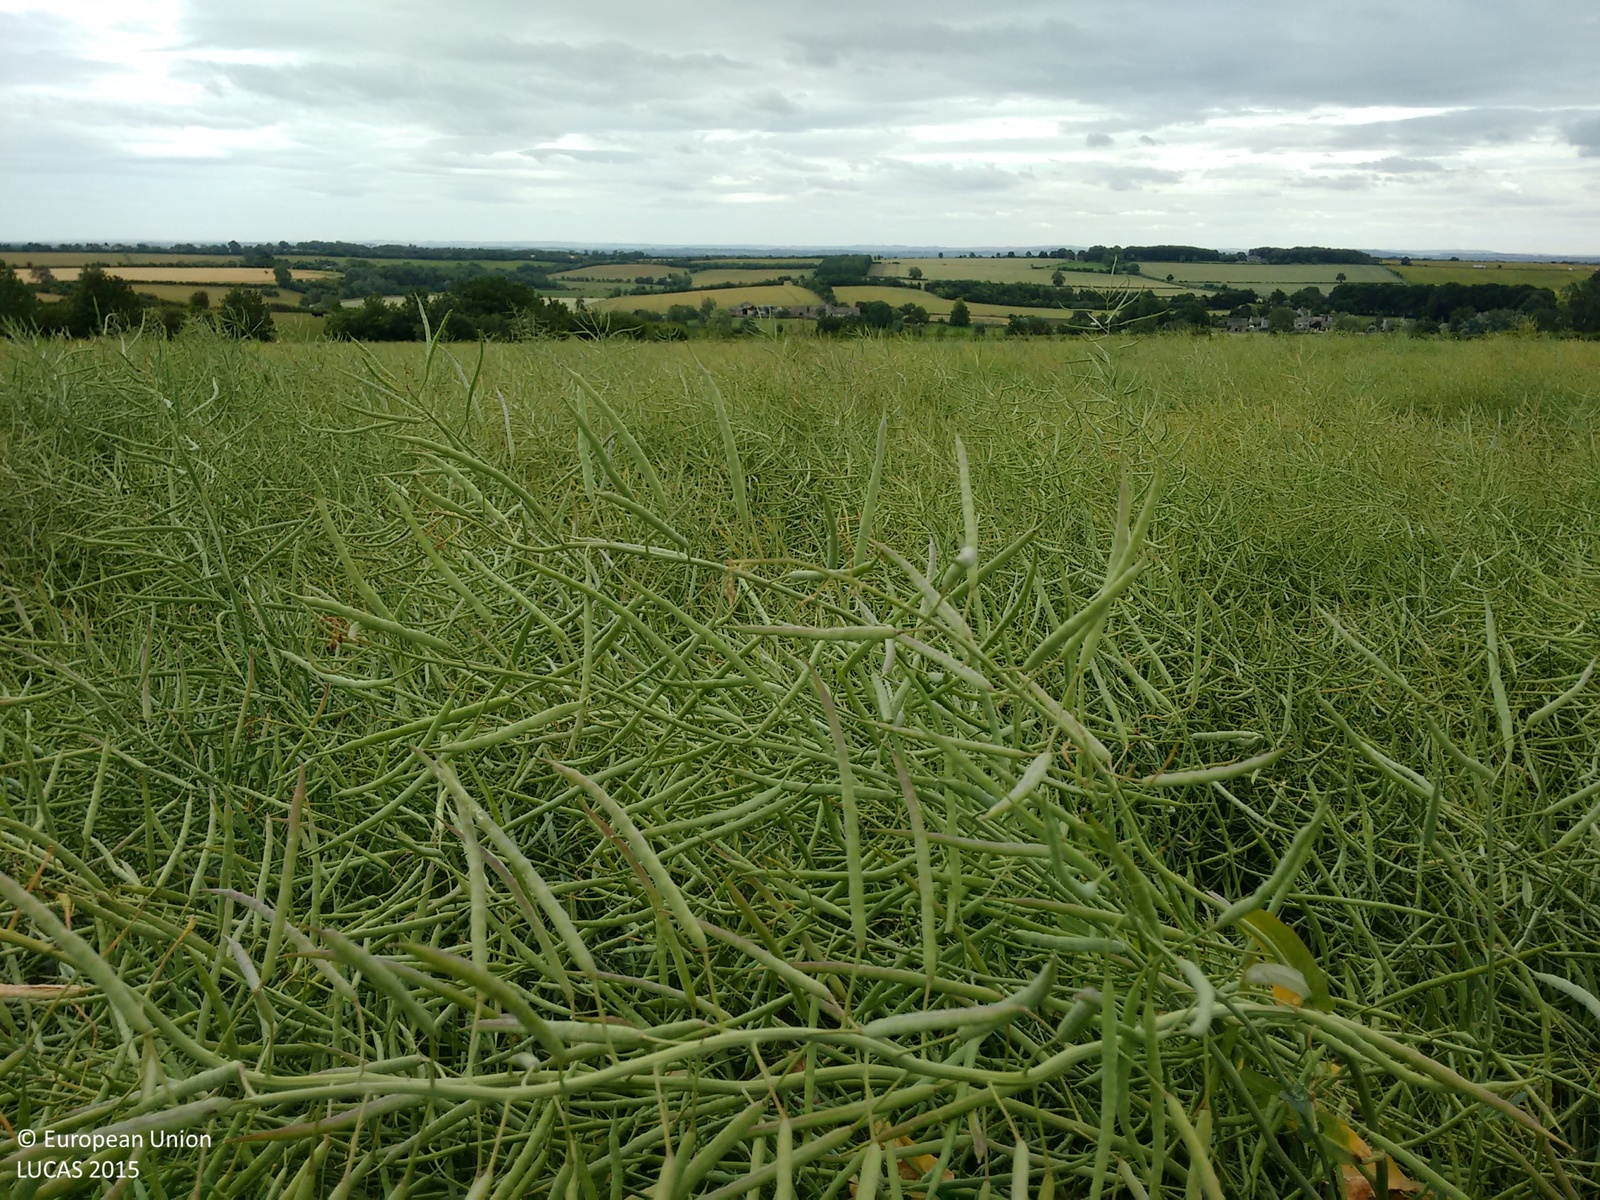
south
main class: Cropland
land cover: Rape and turnip rape
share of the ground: > 75 %
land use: Agriculture (excluding fallow land and kitchen gardens)
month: July
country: GB
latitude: 51.8082
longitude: -1.5828
